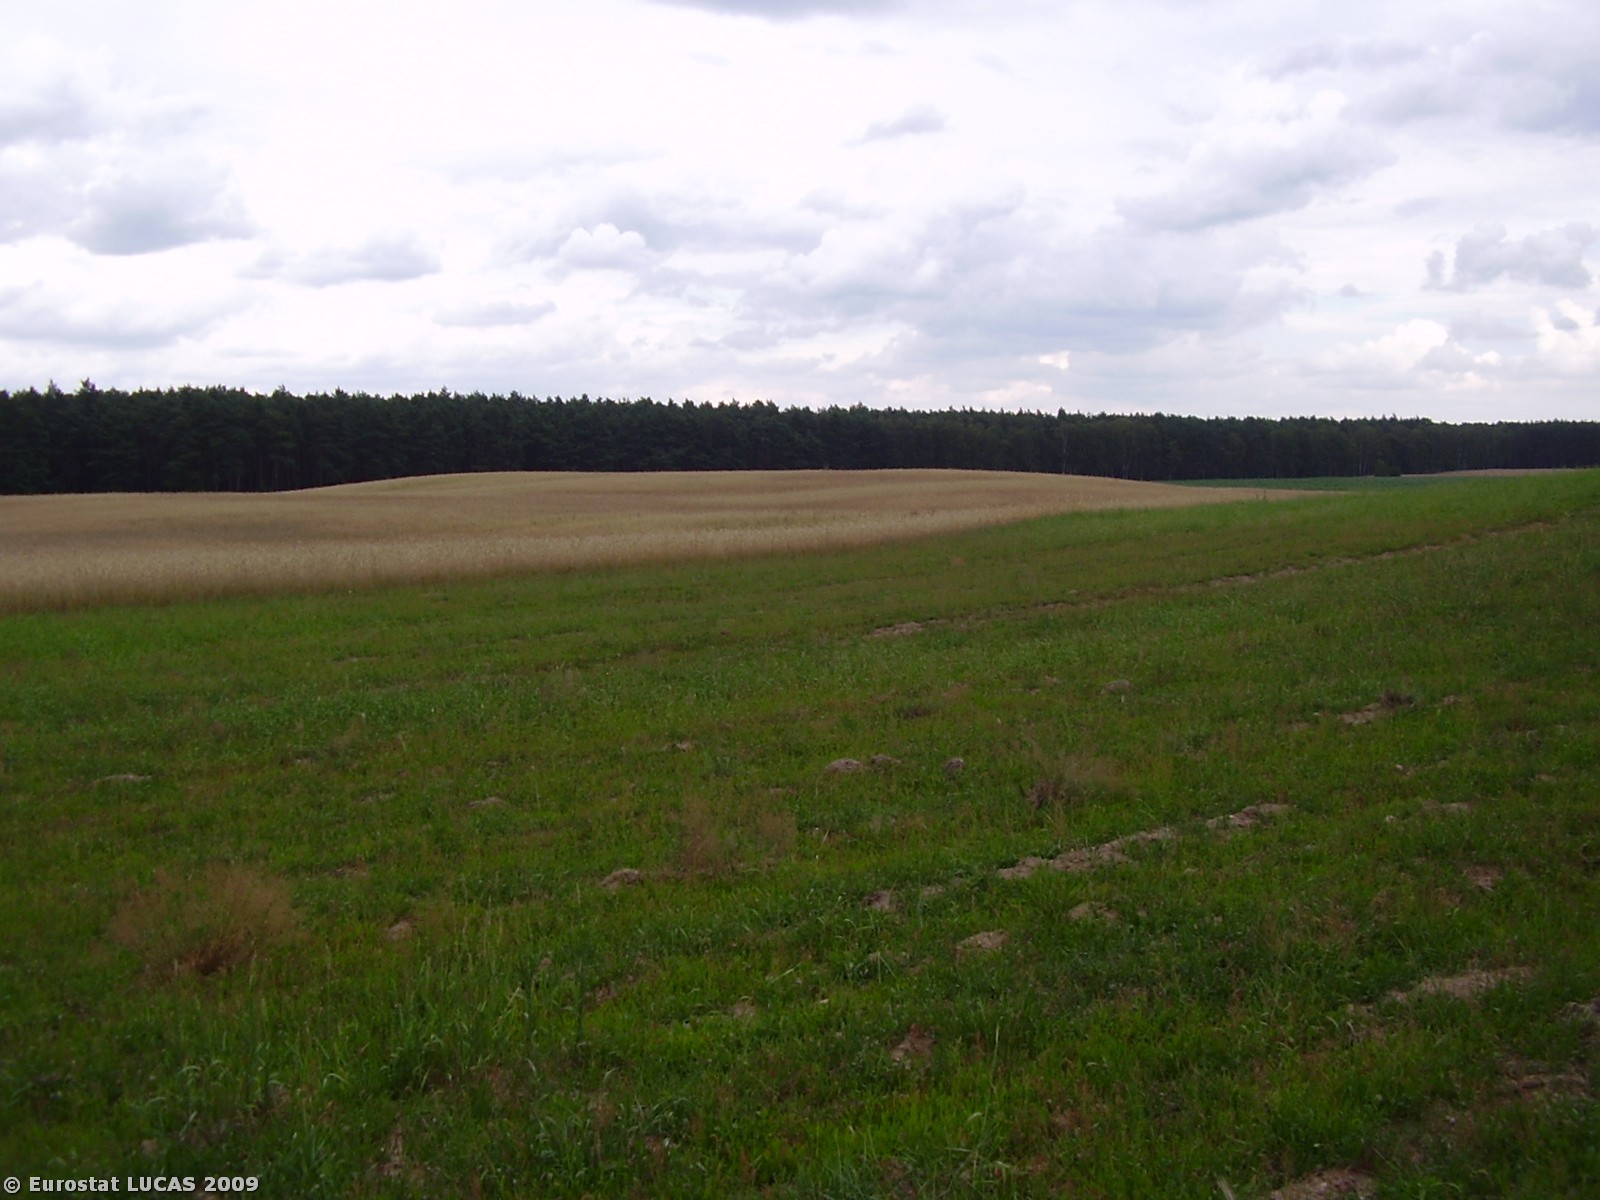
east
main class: Grassland
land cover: Grassland without tree/shrub cover
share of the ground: > 75 %
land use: Fallow land
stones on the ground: 25 - 50 %
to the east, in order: Grassland without tree/shrub cover; Triticale
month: July
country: PL
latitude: 51.8694
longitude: 16.2664
